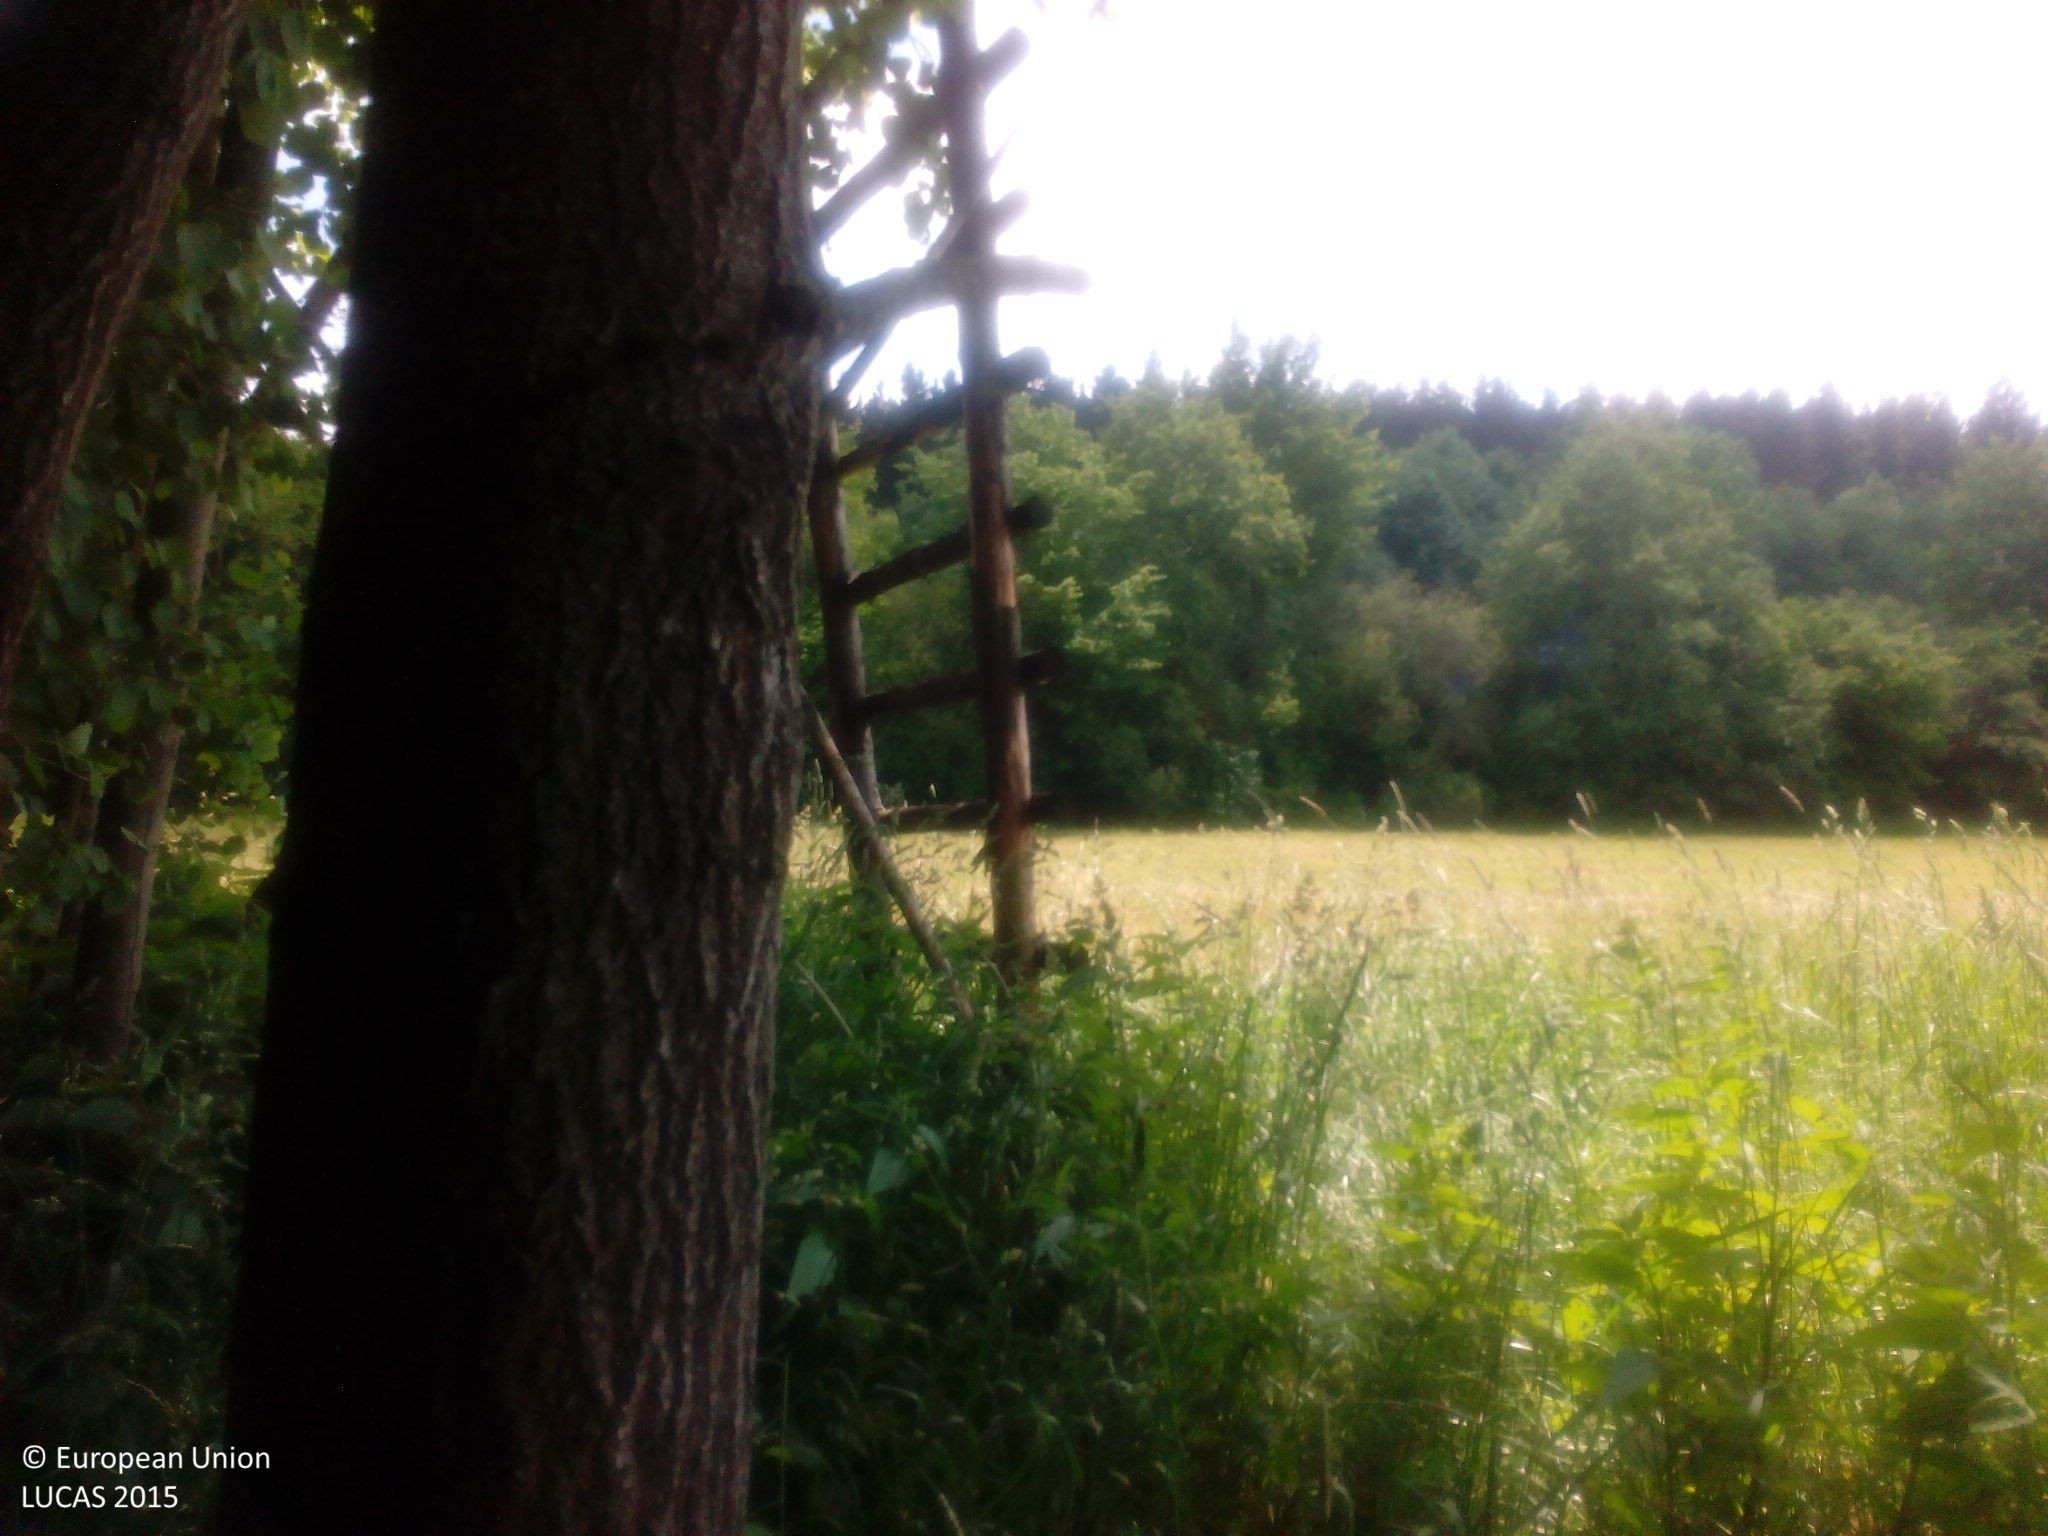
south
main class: Woodland
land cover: Broadleaved woodland
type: mesophytic deciduous forest
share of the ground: > 75 %
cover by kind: broadleaved forest trees 80 %, shrubs 10 %, herbaceous plants 10 %
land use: Forestry
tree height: > 5 m
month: June
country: DE
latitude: 48.4316
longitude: 12.3913
